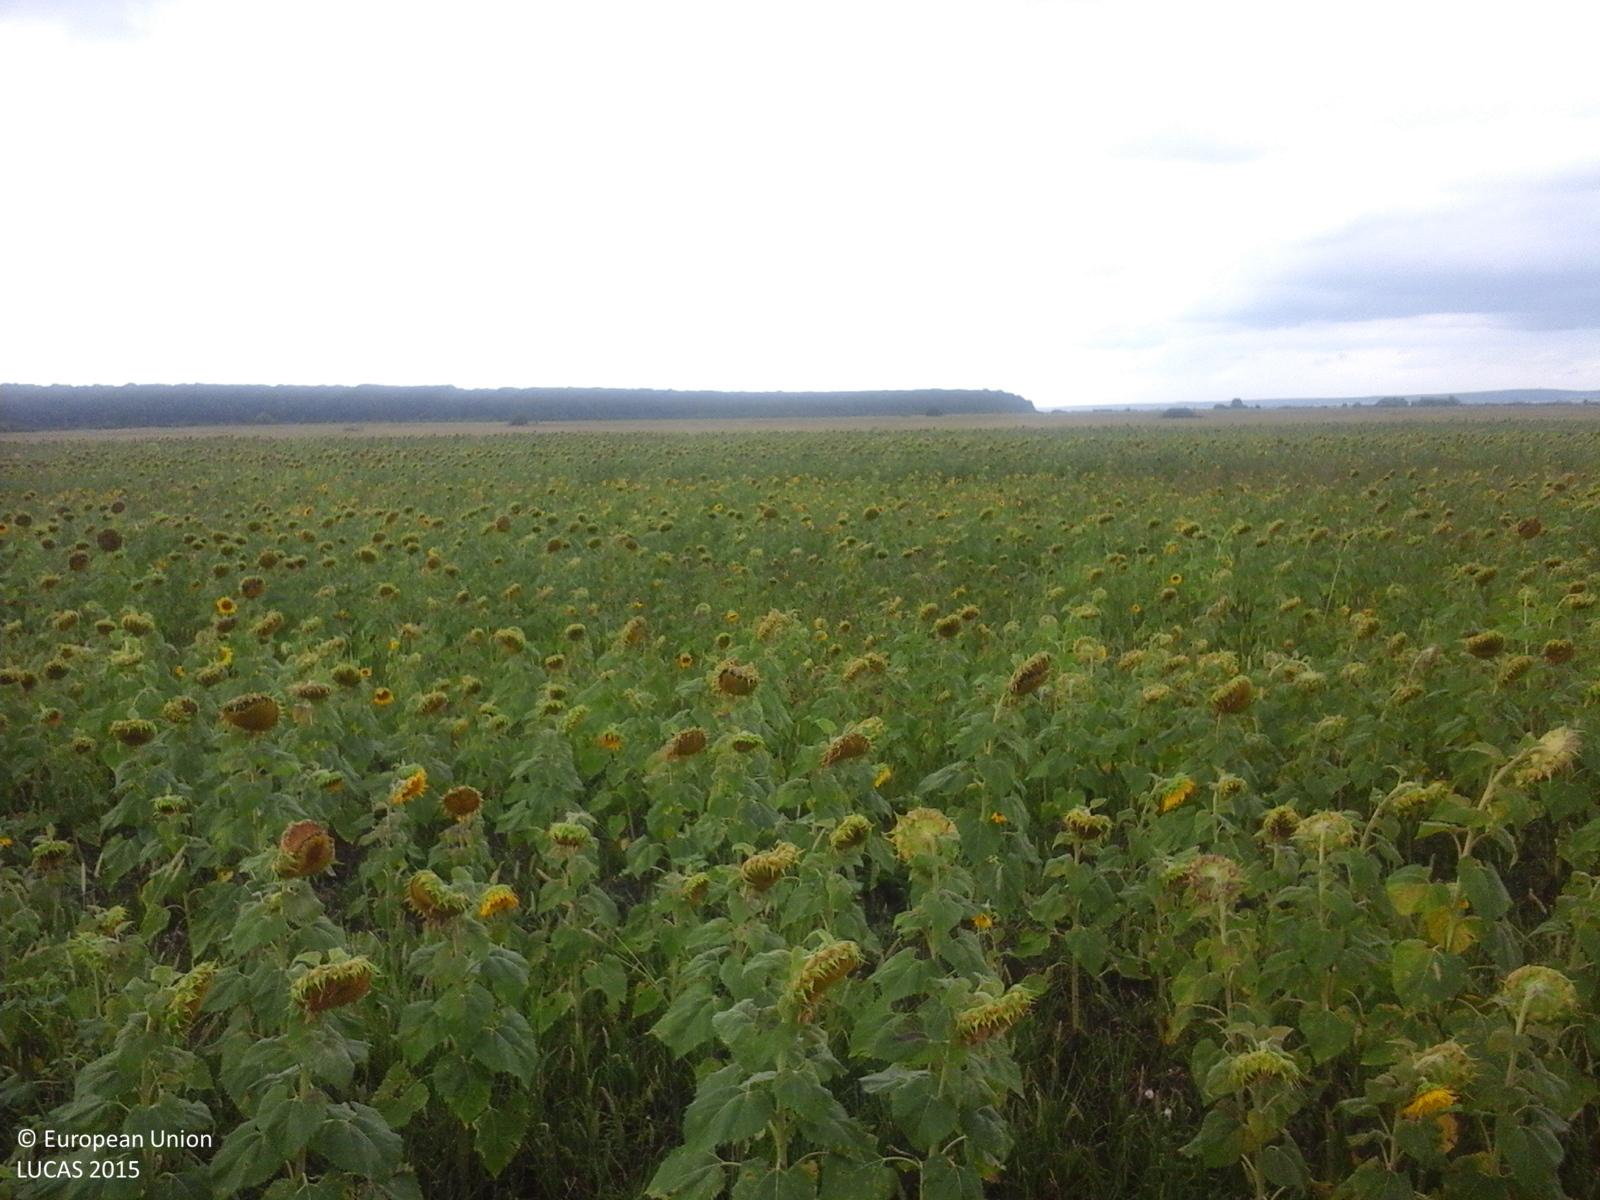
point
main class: Cropland
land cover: Sunflower
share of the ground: > 75 %
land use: Agriculture (excluding fallow land and kitchen gardens)
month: August
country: RO
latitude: 45.7372
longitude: 21.5884
